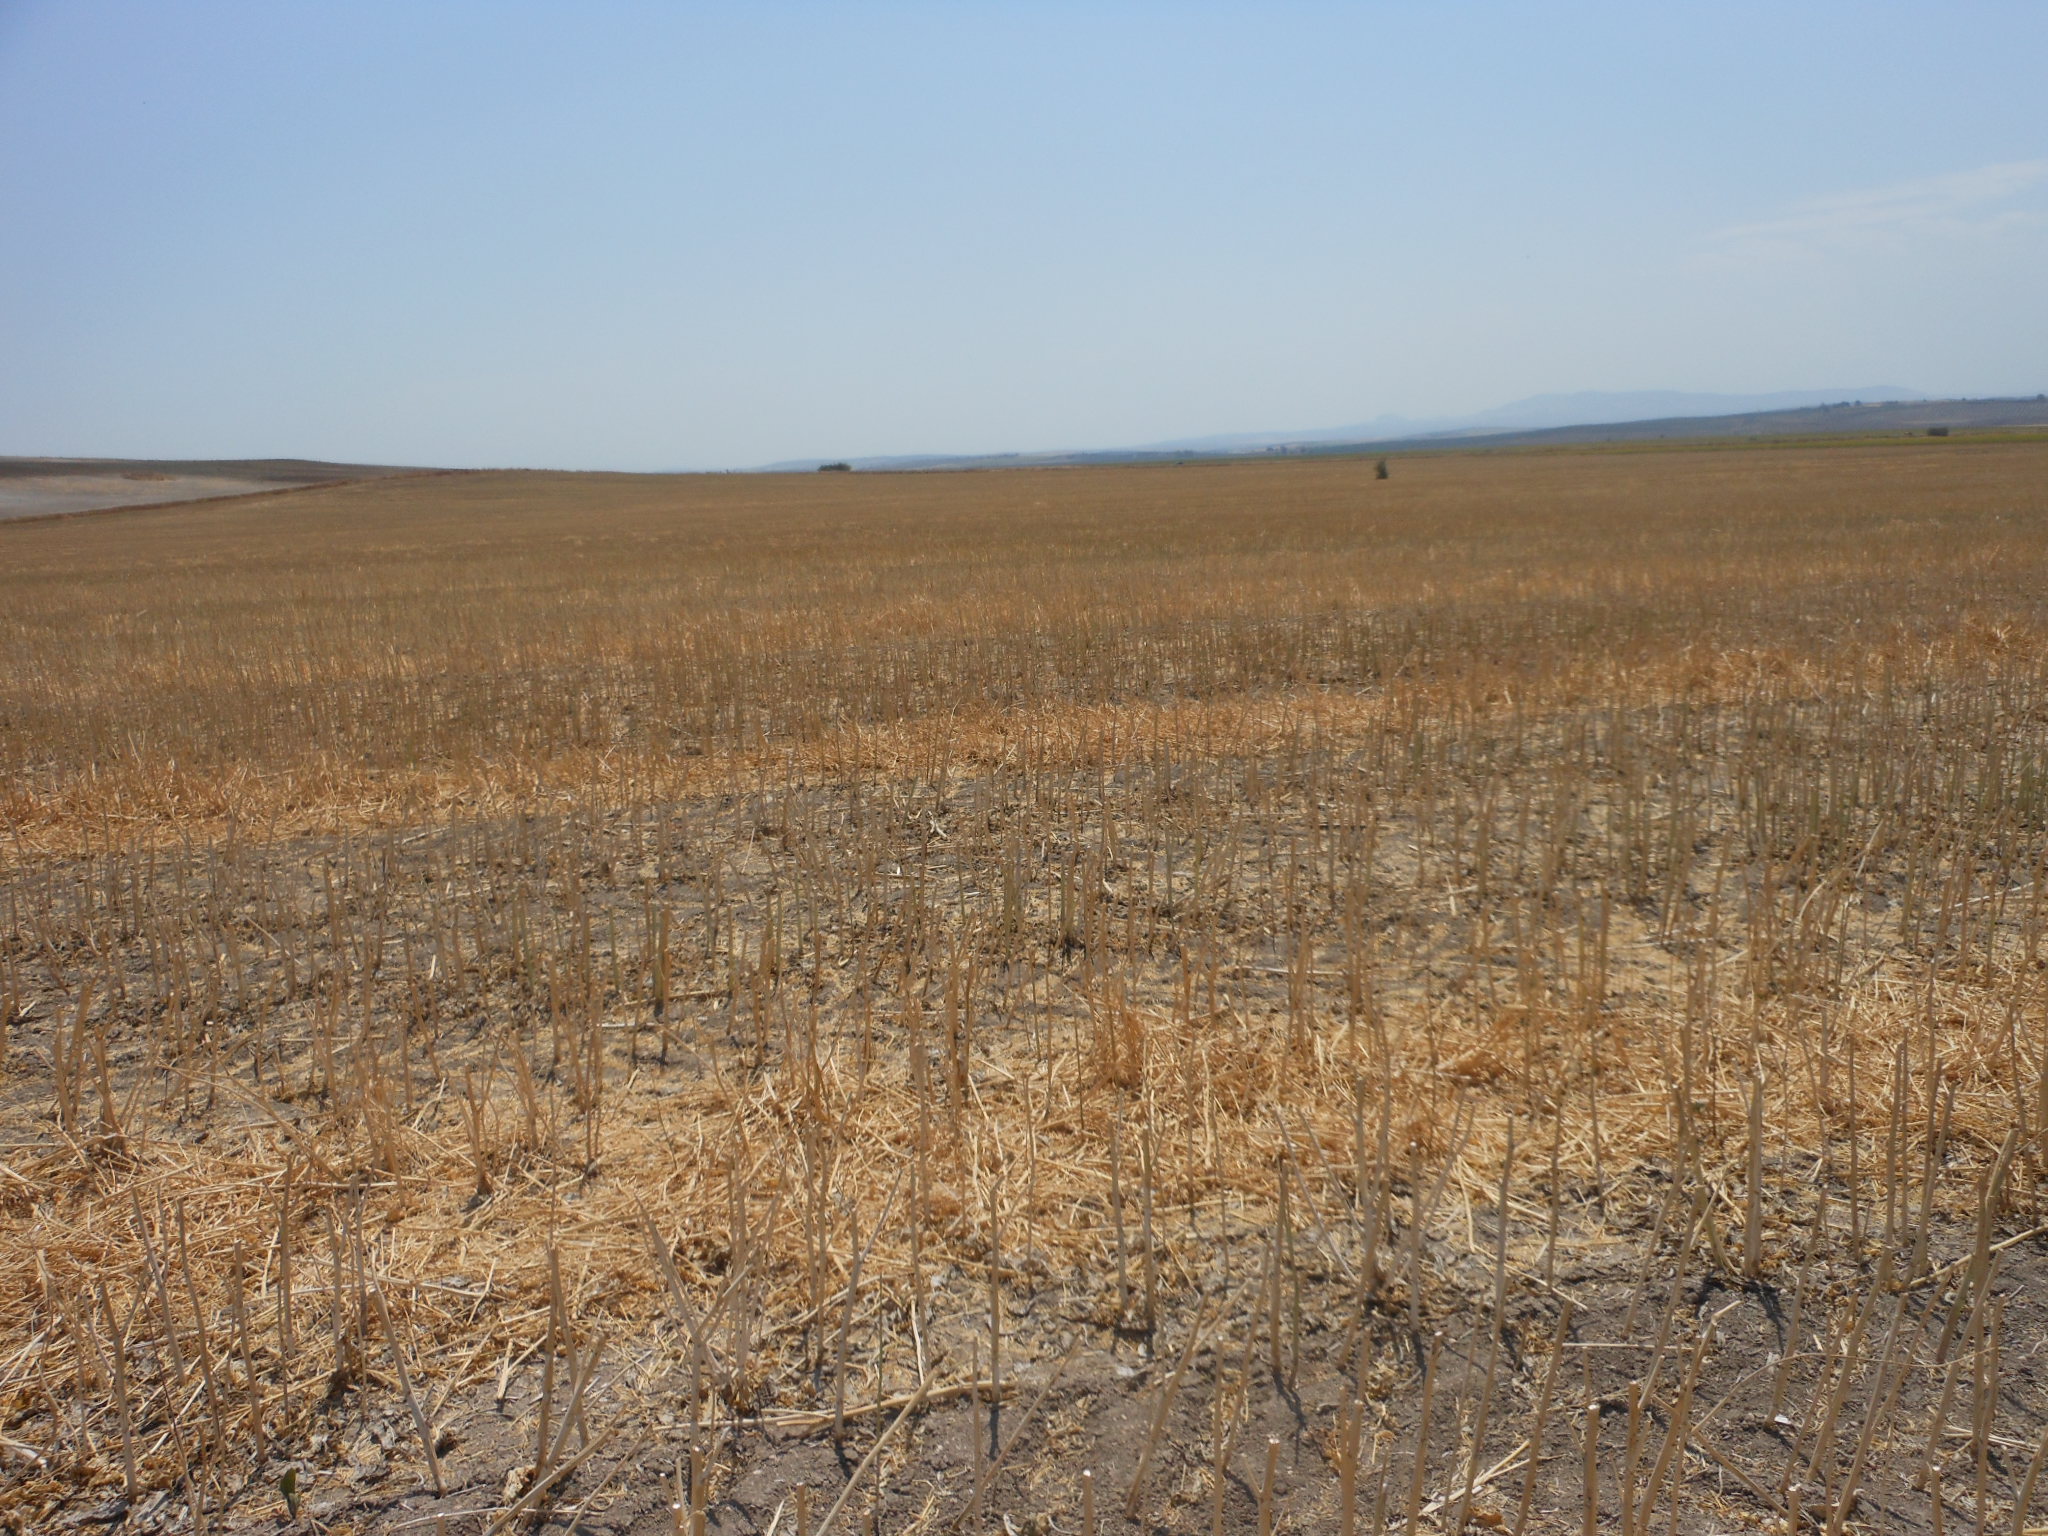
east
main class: Cropland
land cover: Sunflower
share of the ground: 50 - 75 %
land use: Agriculture (excluding fallow land and kitchen gardens)
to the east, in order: Sunflower; Electric lines; Sunflower; Other structural elements; Grass margins; Sunflower
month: June
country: ES
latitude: 37.4328
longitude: -5.1212
